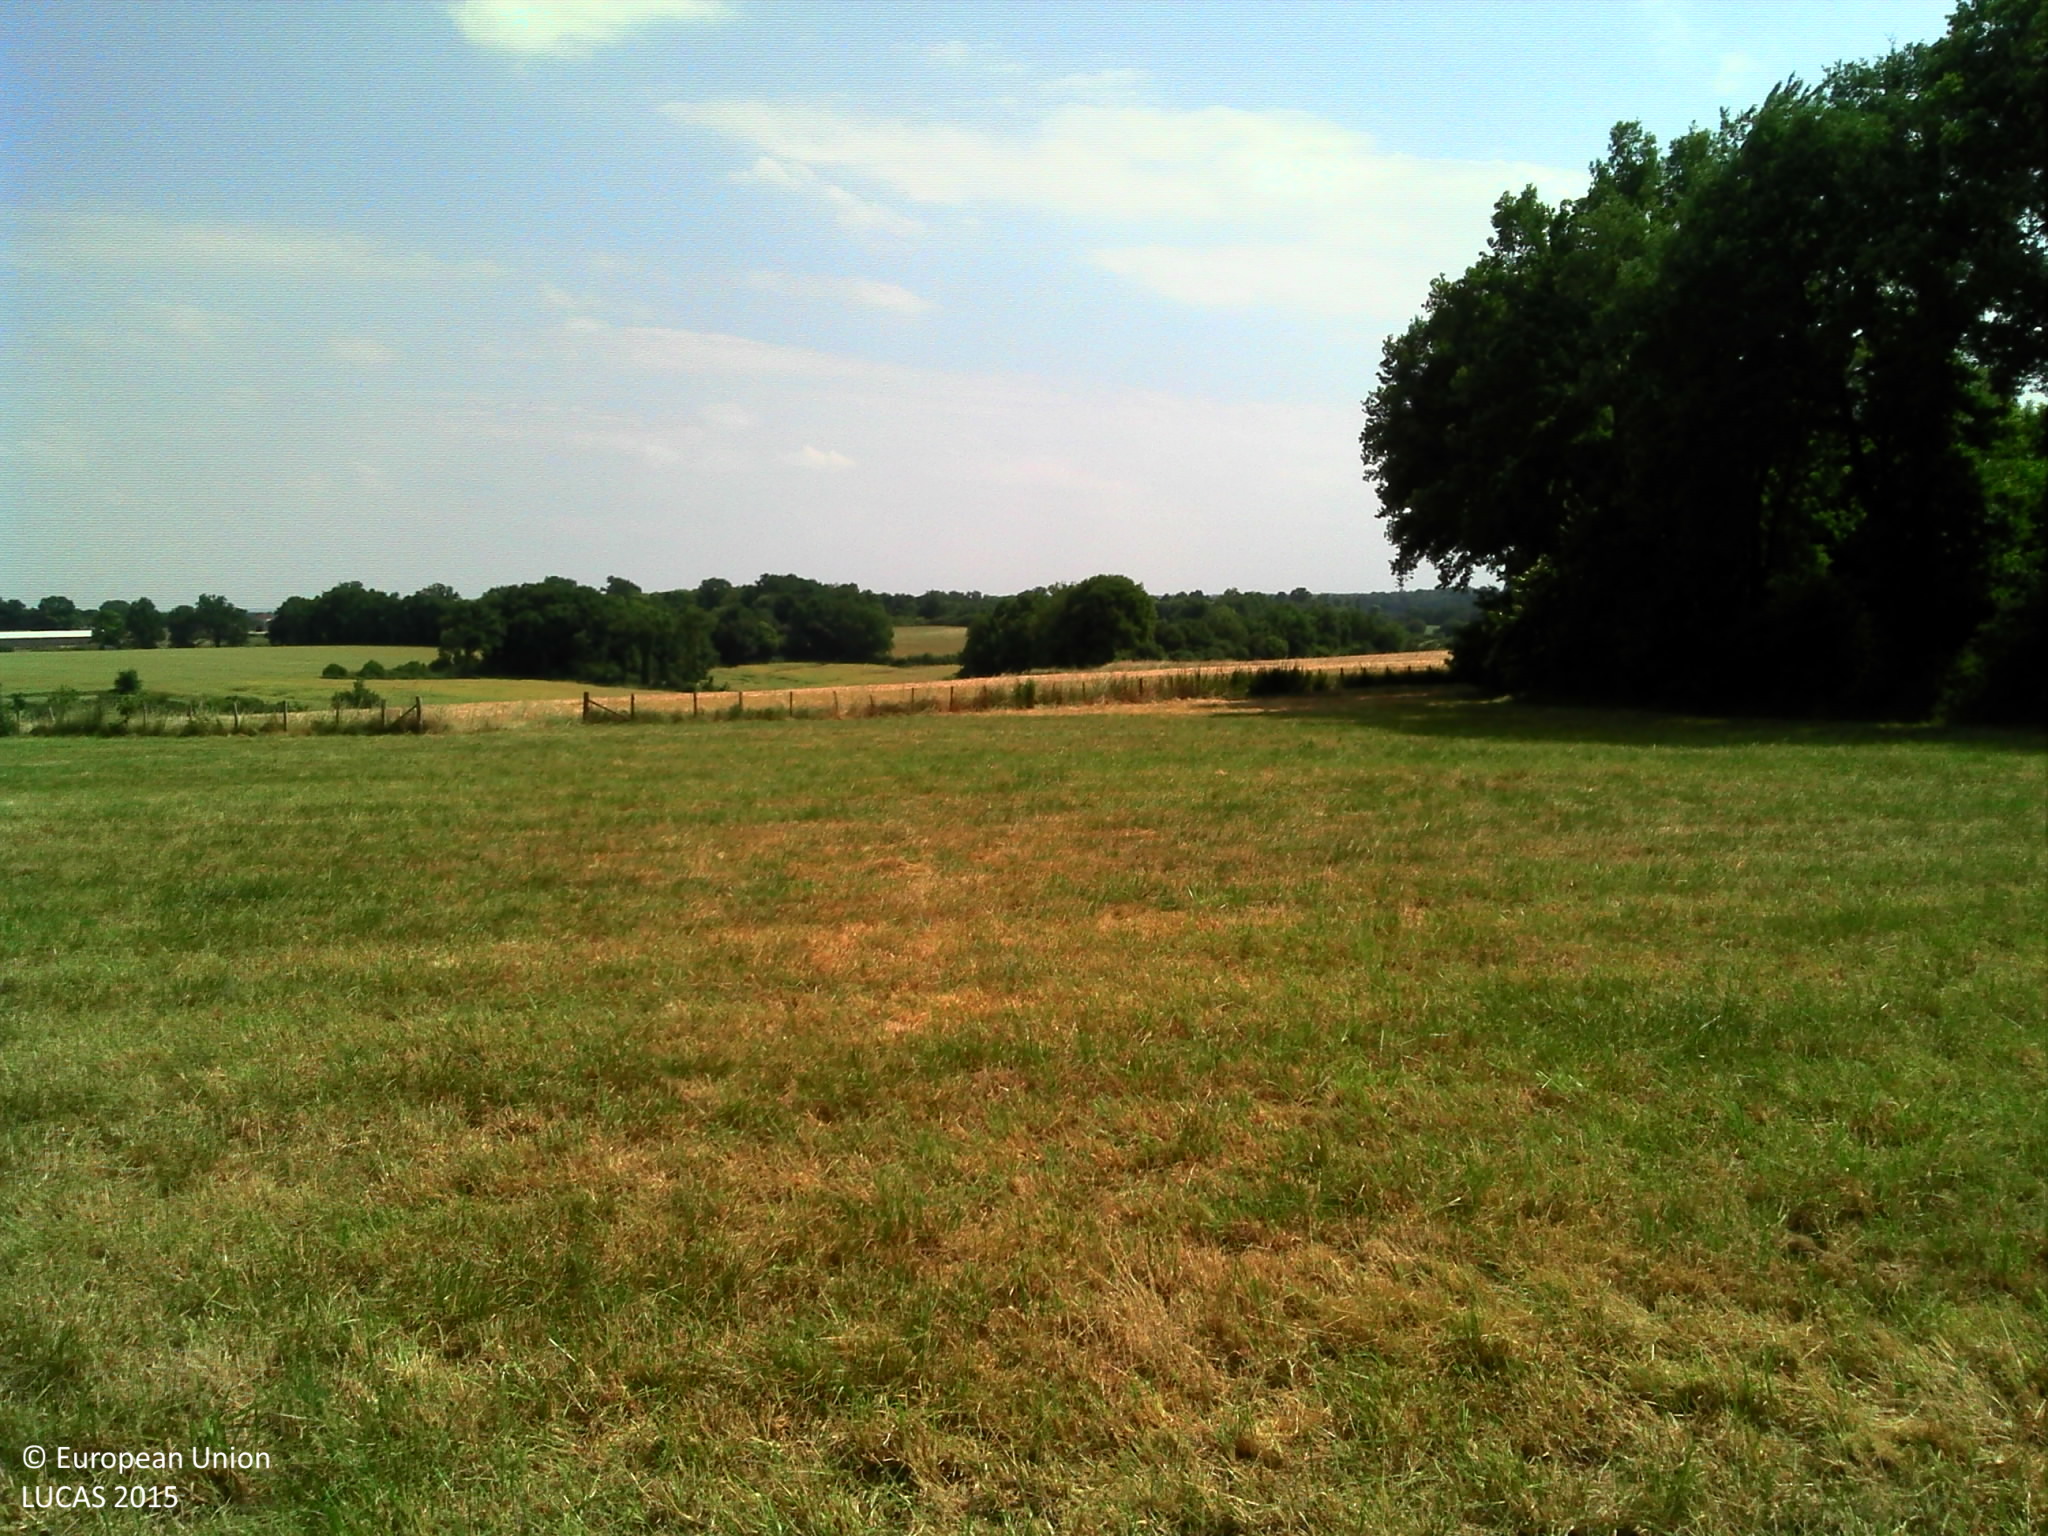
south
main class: Grassland
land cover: Grassland without tree/shrub cover
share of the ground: > 75 %
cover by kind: herbaceous plants 100 %
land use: Agriculture (excluding fallow land and kitchen gardens)
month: June
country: FR
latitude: 45.9344
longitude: 0.3756
